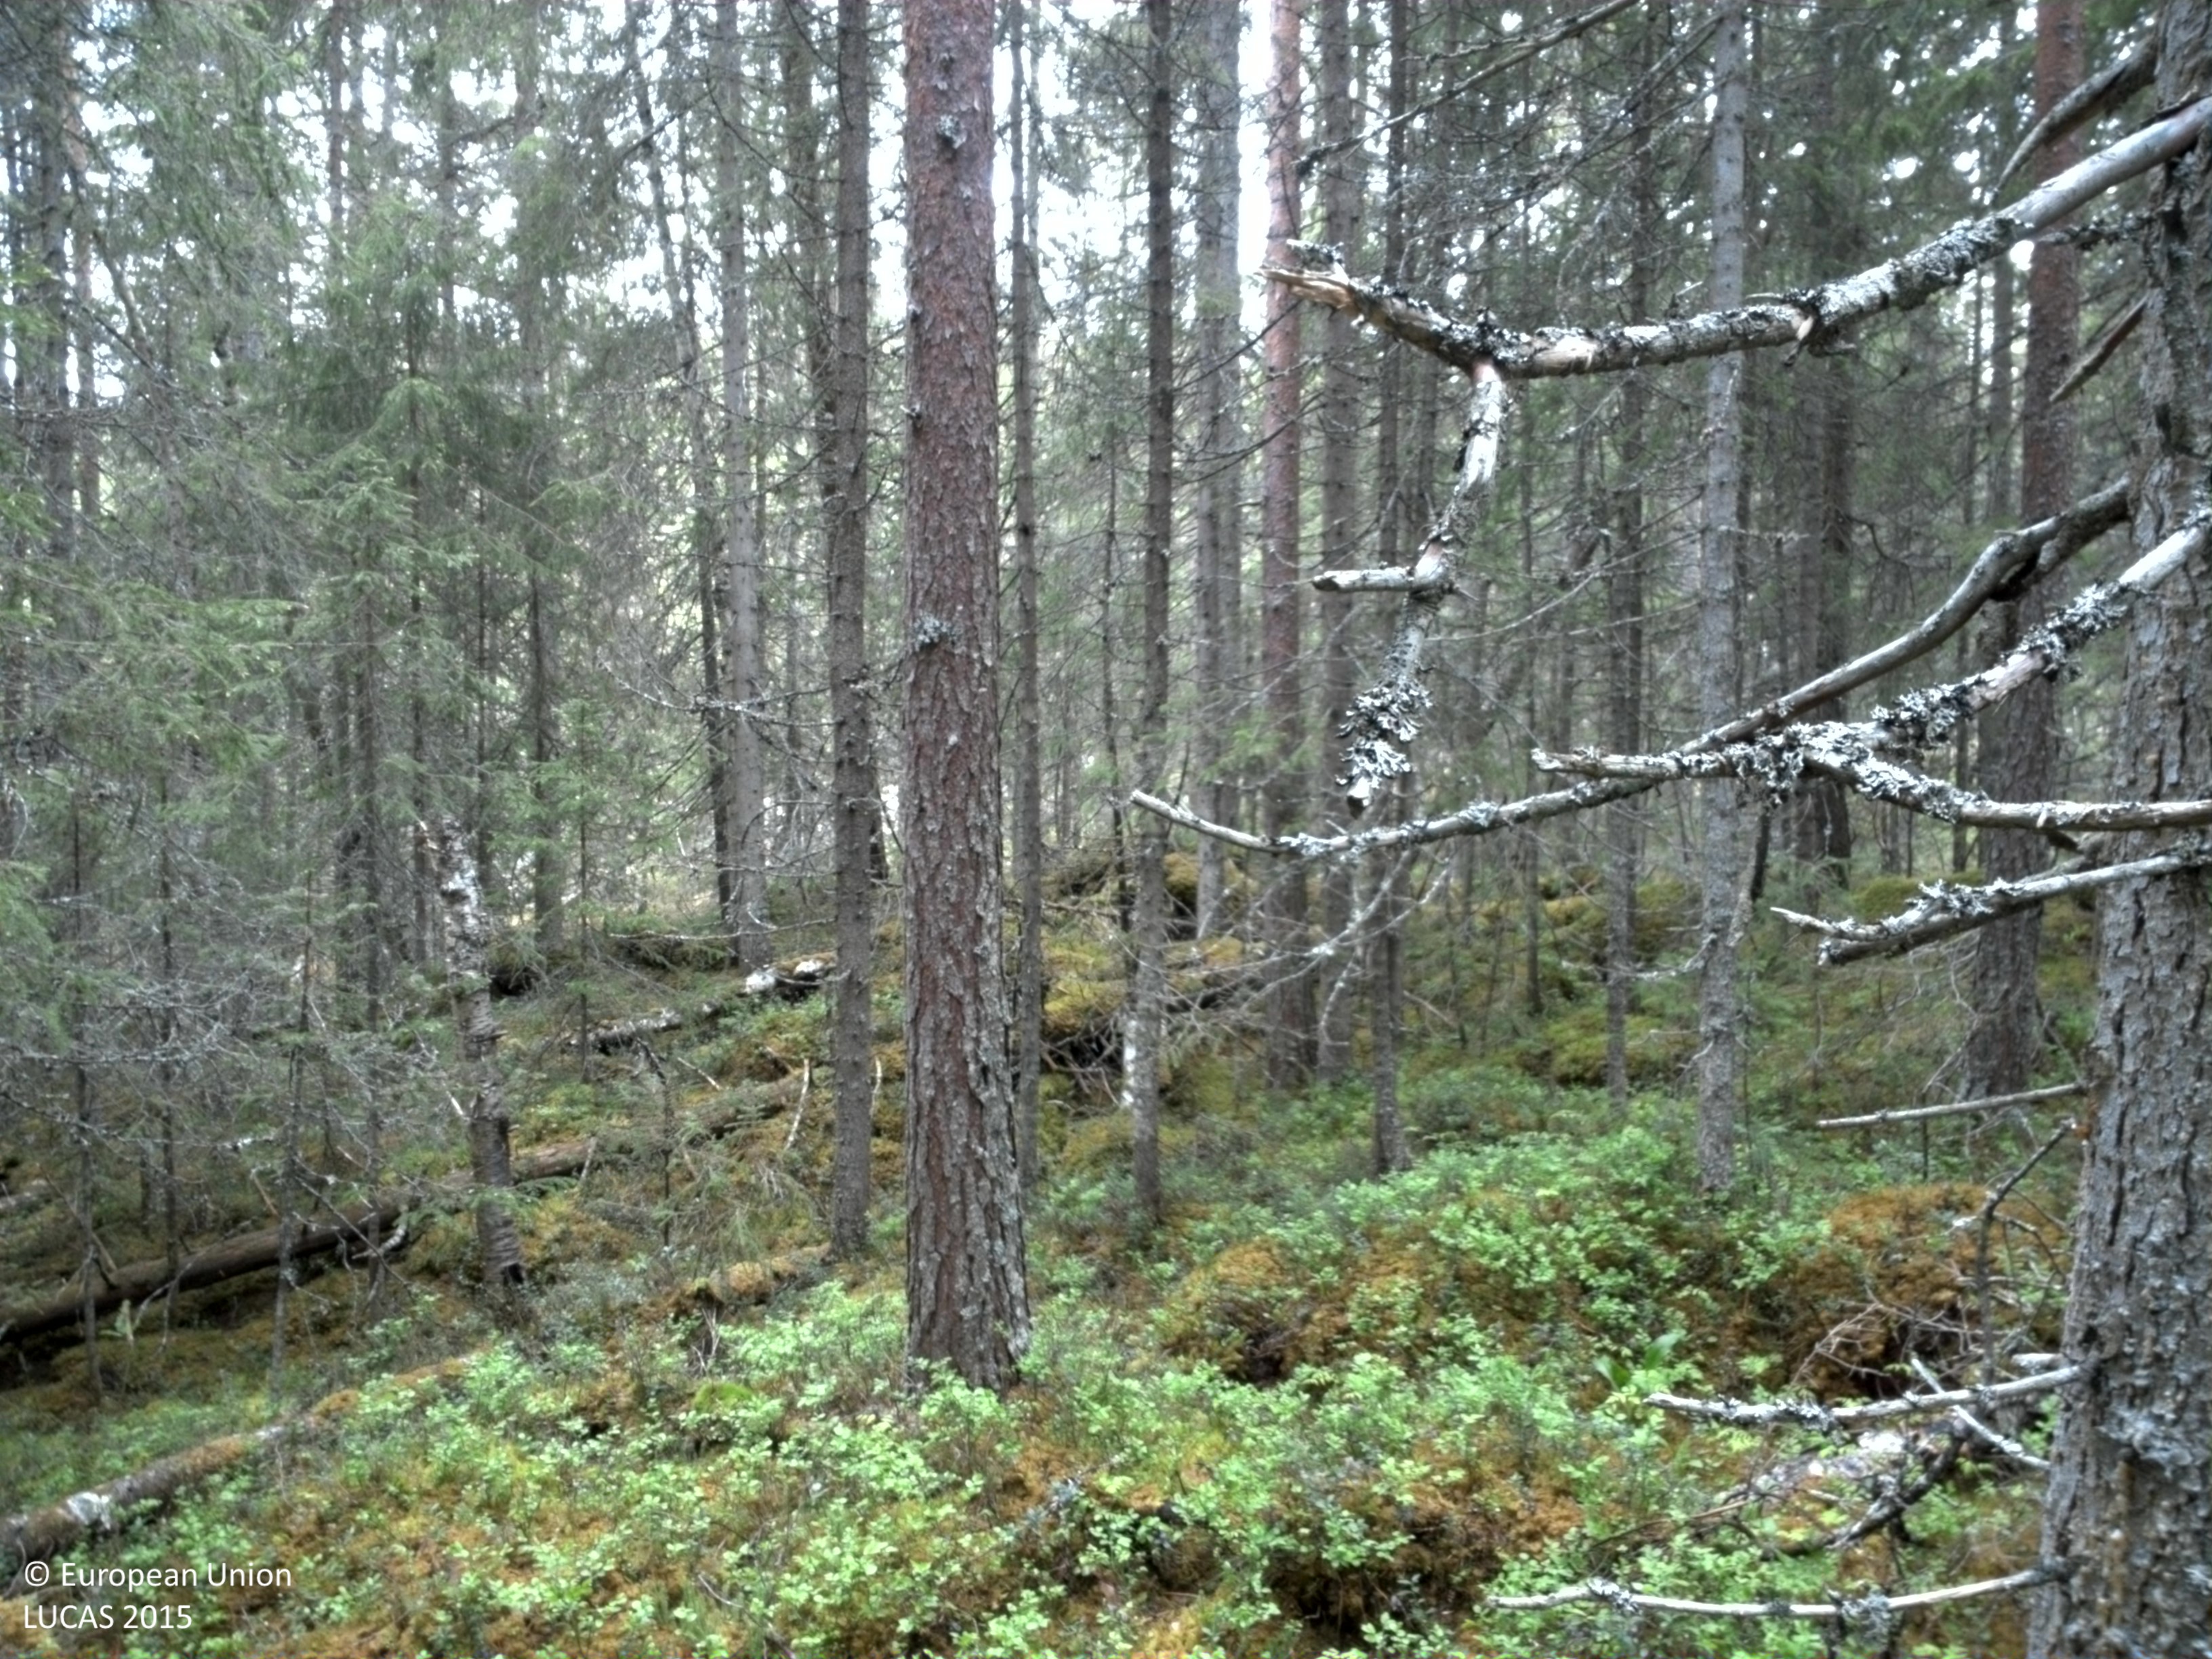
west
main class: Woodland
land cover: Spruce dominated coniferous woodland
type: boreal forest
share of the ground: > 75 %
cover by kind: coniferous forest trees 80 %, shrubs 10 %, lichens and mosses 10 %
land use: Forestry
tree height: > 5 m
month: June
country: SE
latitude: 62.2259
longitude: 13.6206
